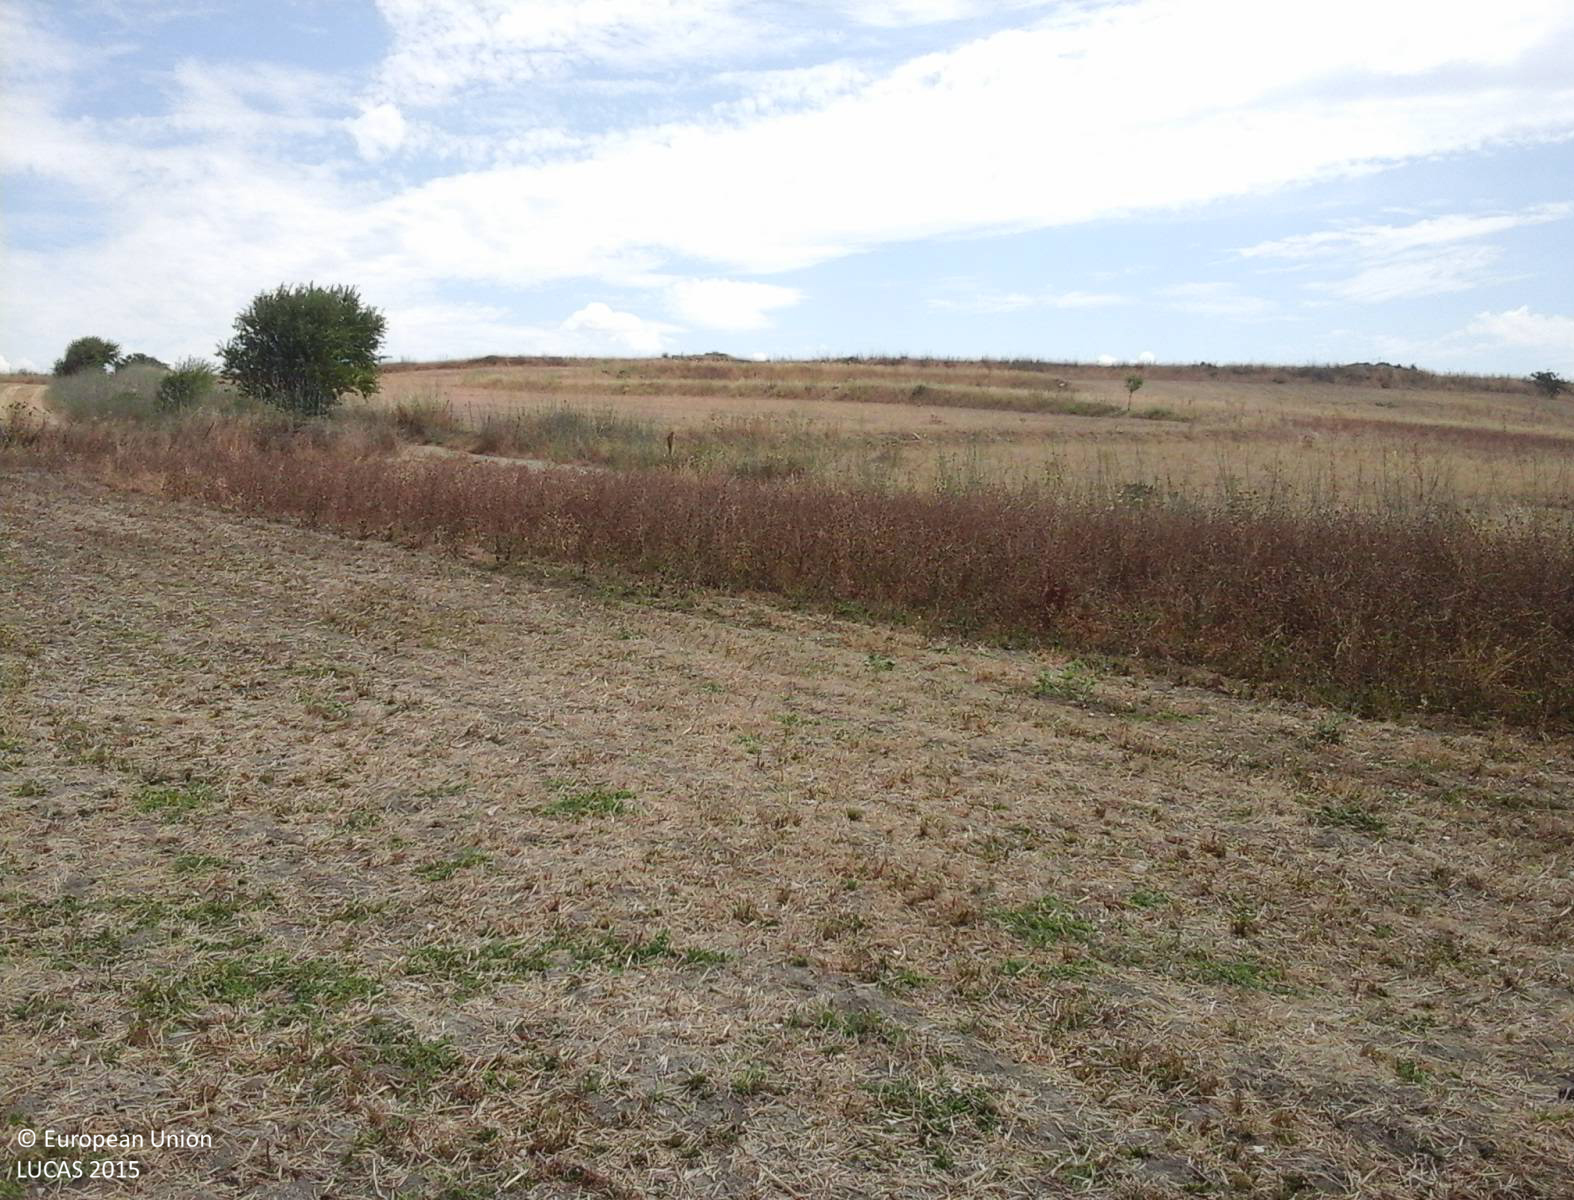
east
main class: Cropland
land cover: Temporary grasslands
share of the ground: > 75 %
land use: Agriculture (excluding fallow land and kitchen gardens)
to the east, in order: Temporary grasslands; Grassland without tree/shrub cover; Grass margins; Tracks; Grass margins; Temporary grasslands; Grass margins; Temporary grasslands; Grass margins; Temporary grasslands; Grass margins; Fences; Temporary grasslands
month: July
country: IT
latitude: 39.7008
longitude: 8.9912
